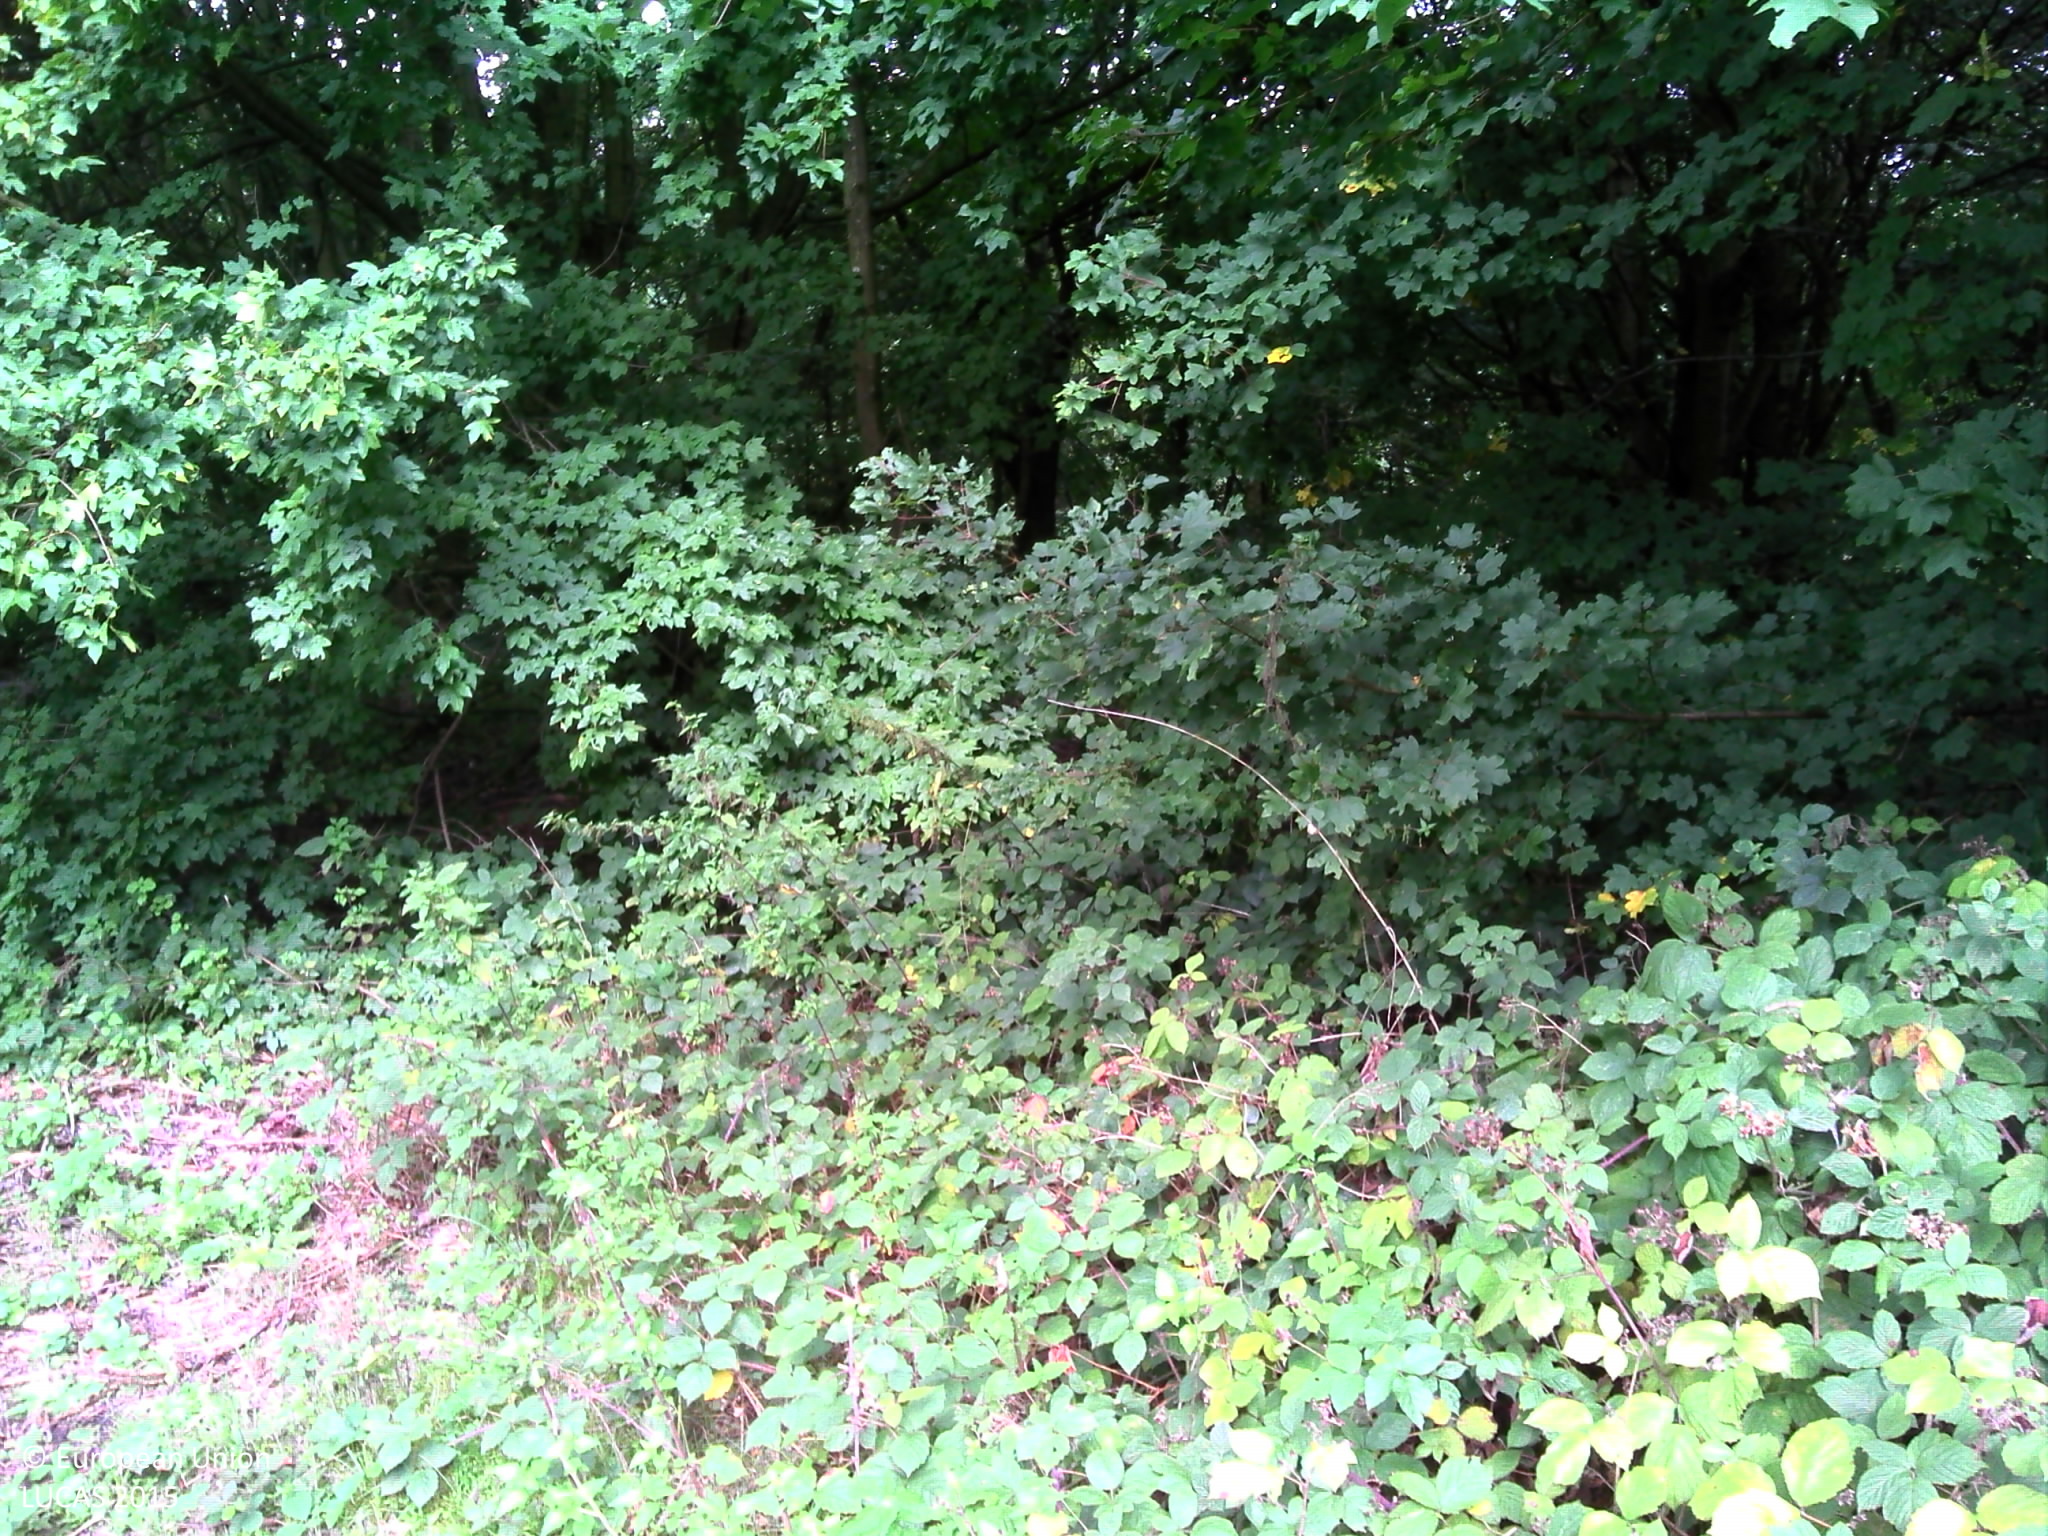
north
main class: Woodland
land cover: Broadleaved woodland
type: mesophytic deciduous forest
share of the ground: > 75 %
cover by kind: broadleaved forest trees 90 %, shrubs 5 %, herbaceous plants 5 %
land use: Amenities, museums, leisure
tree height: > 5 m
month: September
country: BE
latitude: 51.1657
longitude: 4.4325
